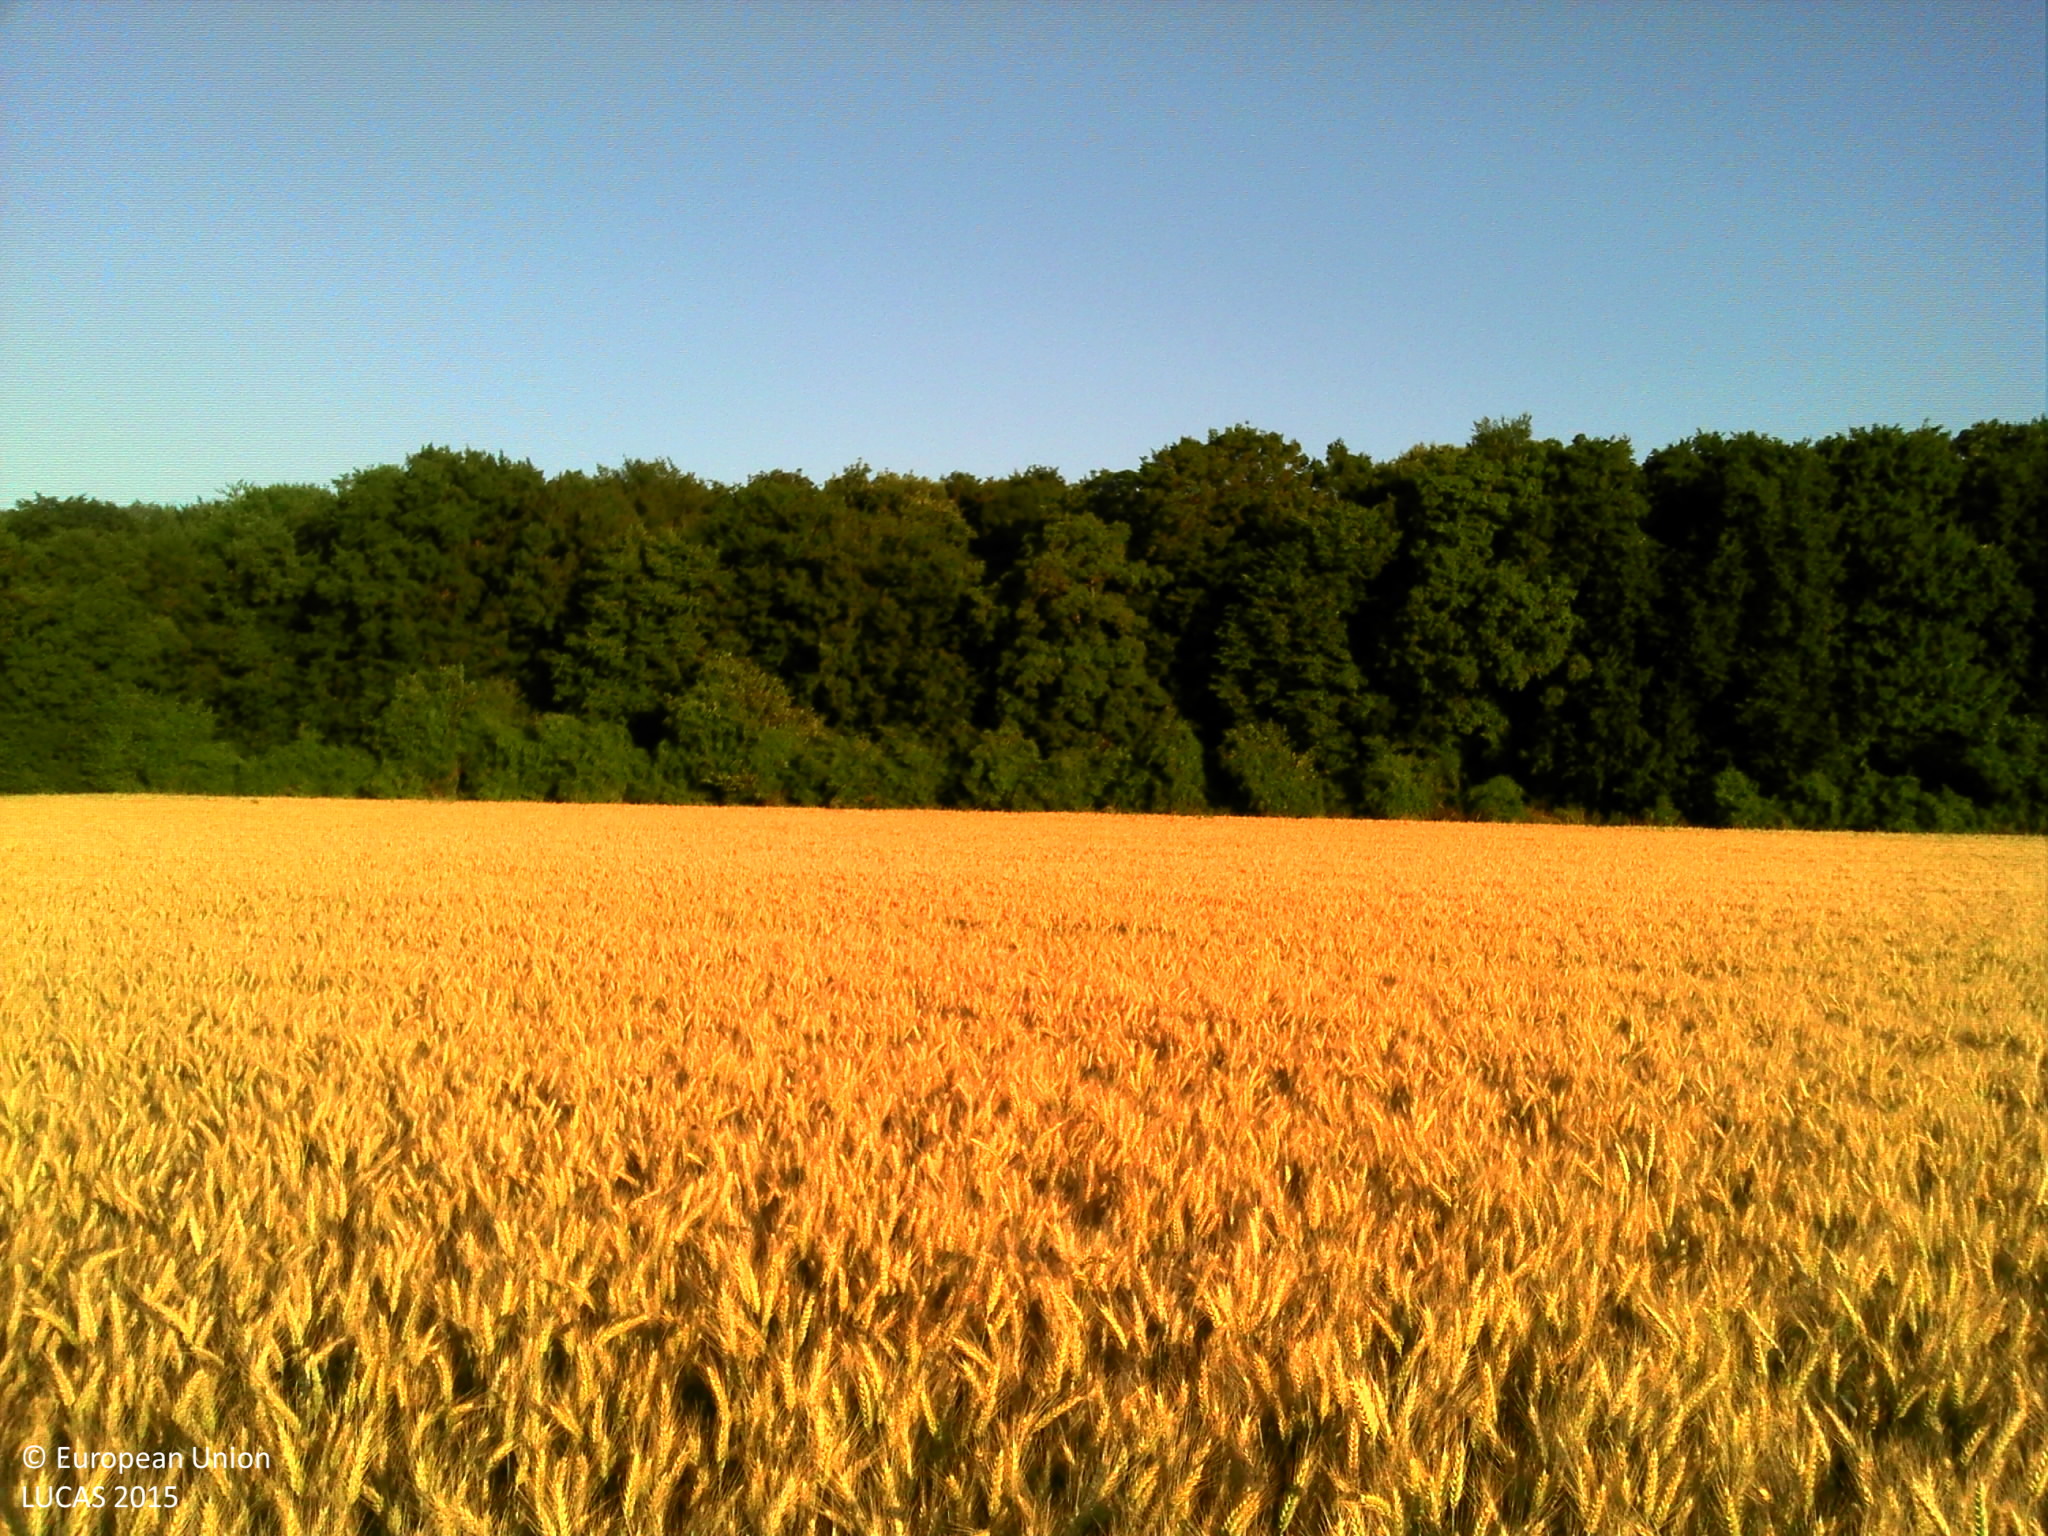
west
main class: Cropland
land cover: Common wheat
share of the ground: > 75 %
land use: Agriculture (excluding fallow land and kitchen gardens)
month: June
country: FR
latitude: 49.4277
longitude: 2.4459
